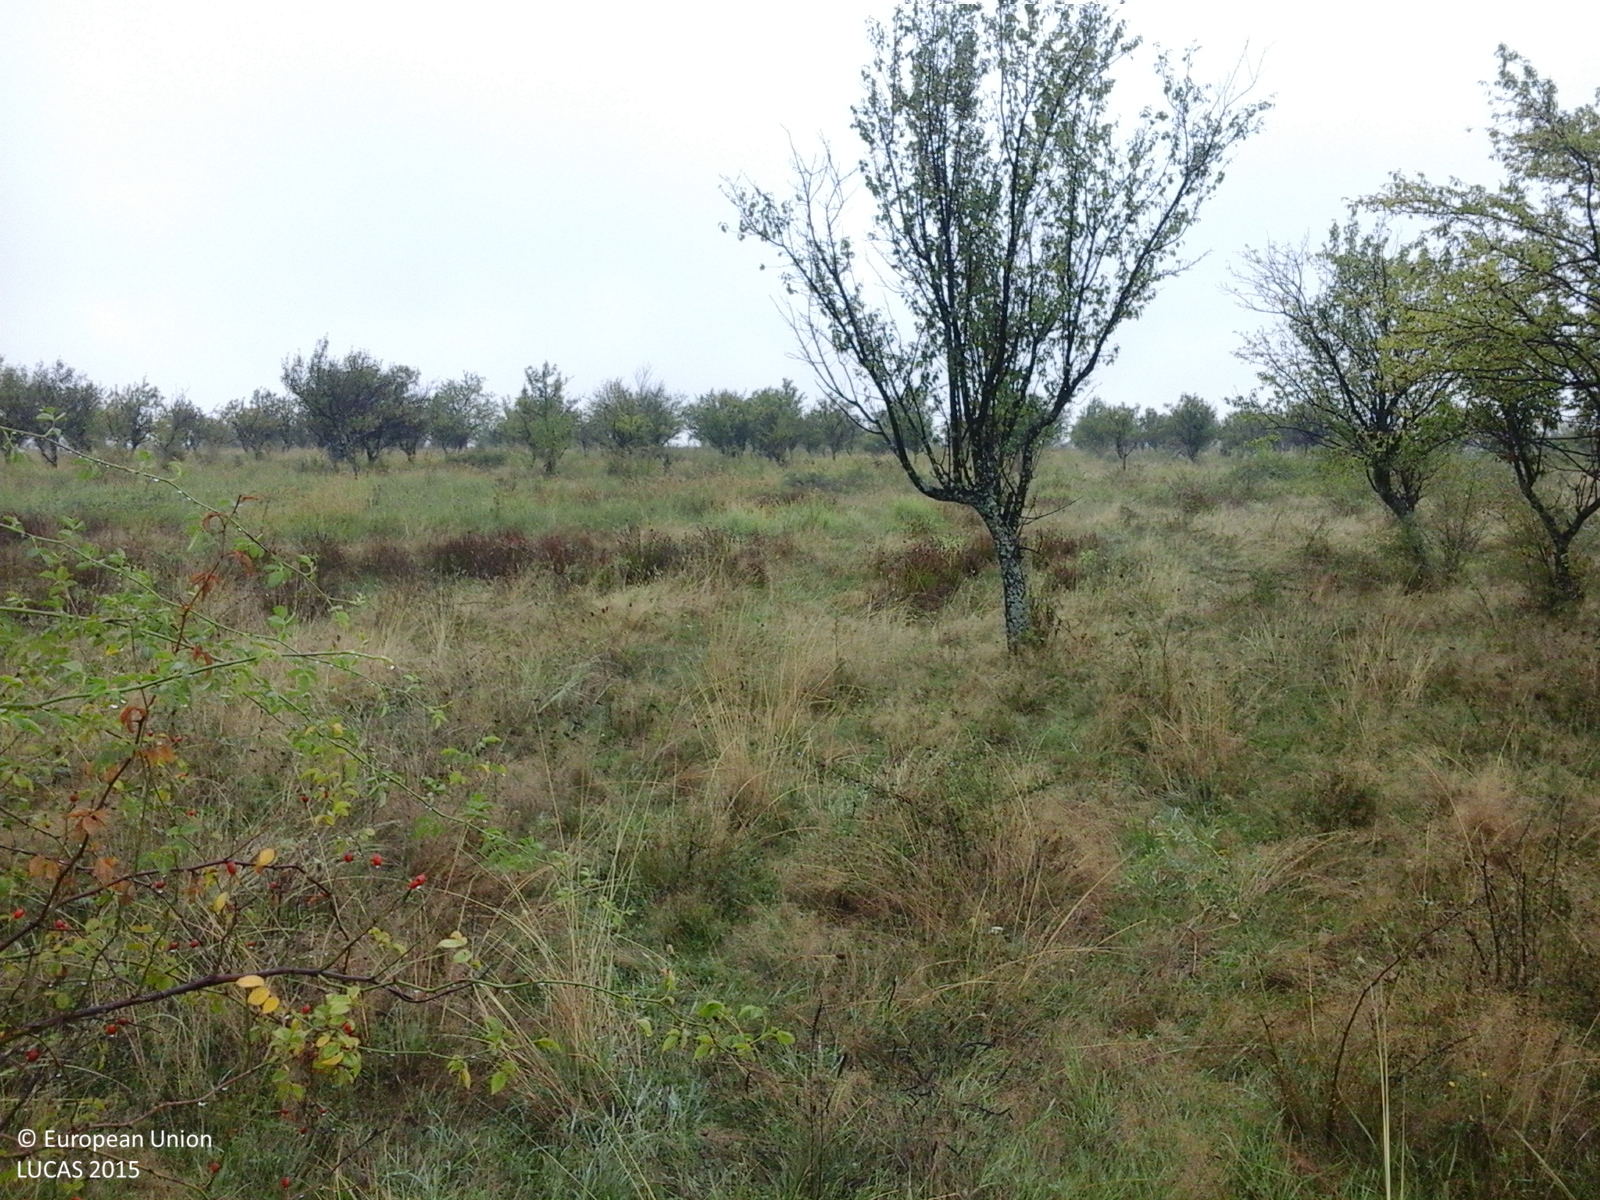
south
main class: Cropland
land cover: Apple fruit
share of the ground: 50 - 75 %
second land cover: Grassland without tree/shrub cover
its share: > 75 %
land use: Agriculture (excluding fallow land and kitchen gardens)
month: September
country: RO
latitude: 45.0809
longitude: 23.5631
